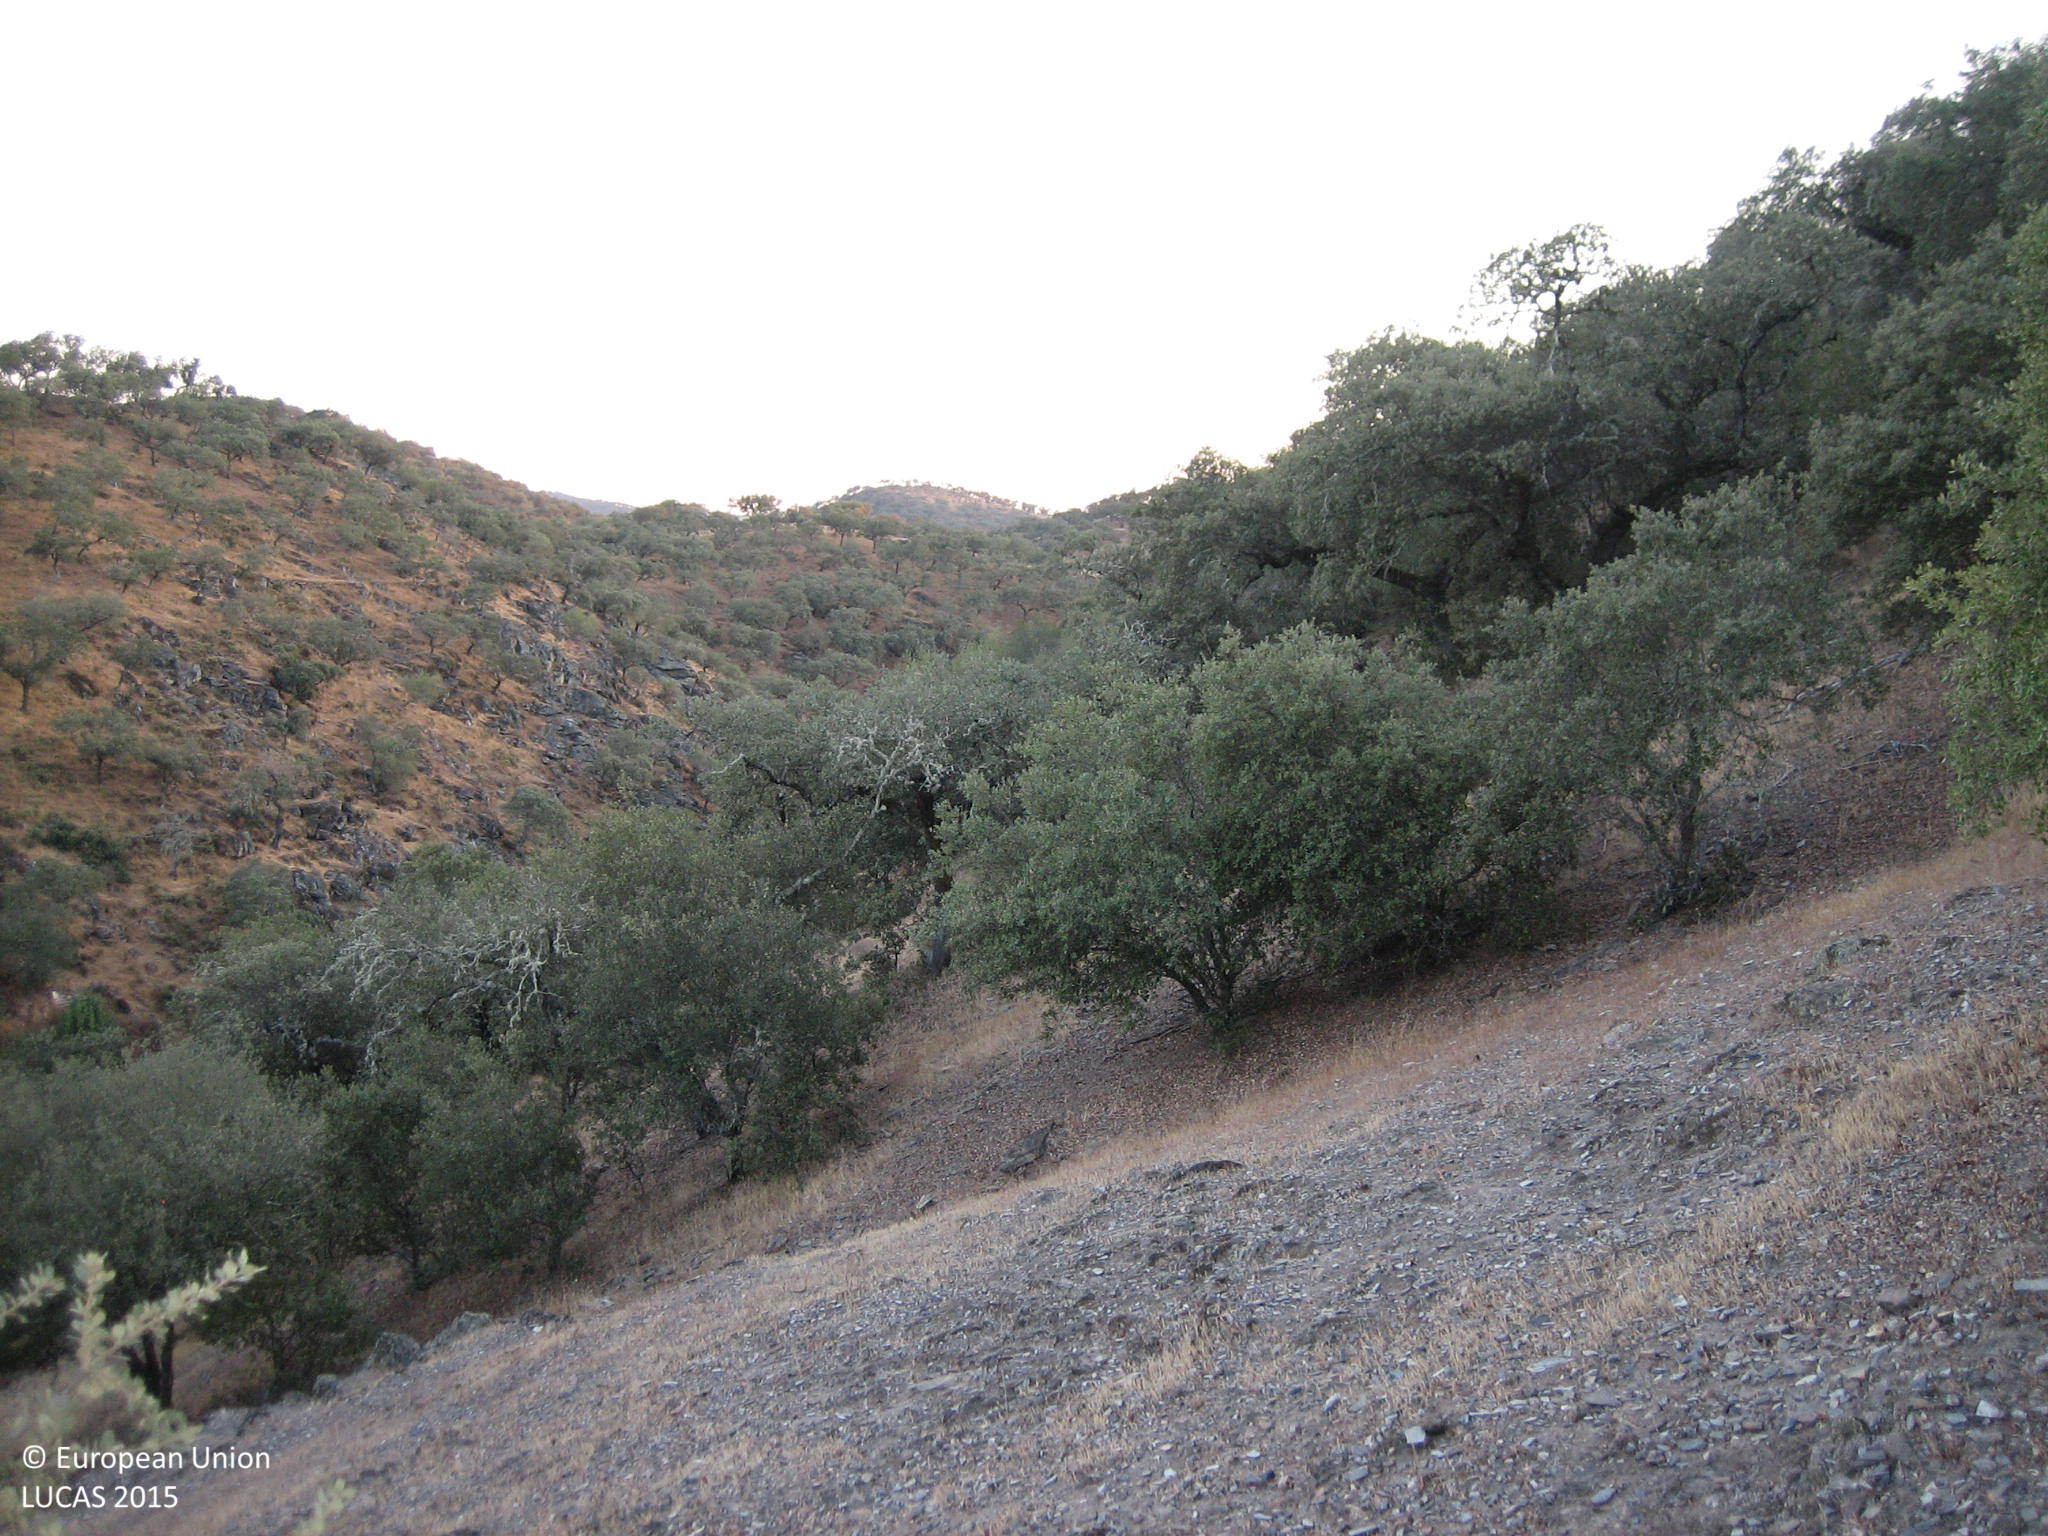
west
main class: Woodland
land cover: Broadleaved woodland
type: broadleaved evergreen forest
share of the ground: 10 - 25 %
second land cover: Shrubland without tree cover
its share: 10 - 25 %
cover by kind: herbaceous plants 40 %, broadleaved forest trees 20 %, shrubs 20 %, unconsolidated bare surface 20 %
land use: Forestry
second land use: Agriculture (excluding fallow land and kitchen gardens)
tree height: < 5 m
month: September
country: ES
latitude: 38.3610
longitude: -7.1271
